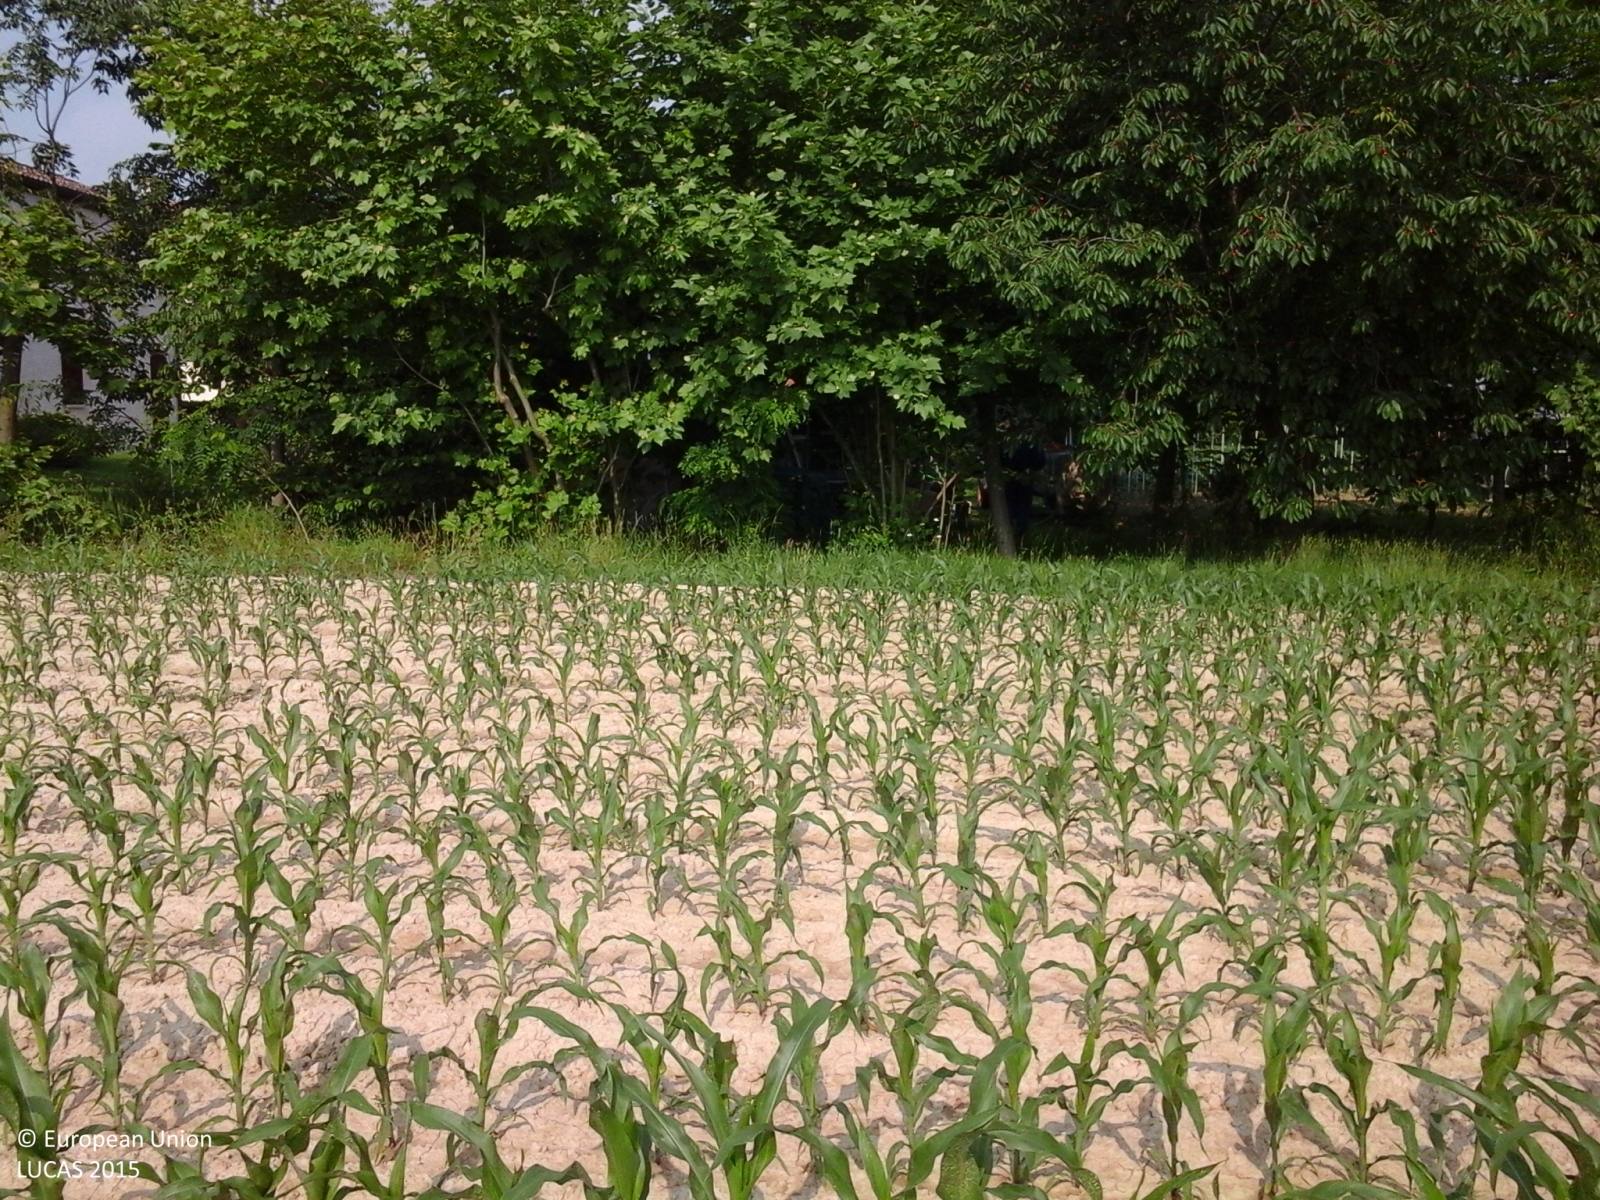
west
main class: Cropland
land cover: Maize
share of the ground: > 75 %
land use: Agriculture (excluding fallow land and kitchen gardens)
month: June
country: IT
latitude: 45.5353
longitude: 12.2120
